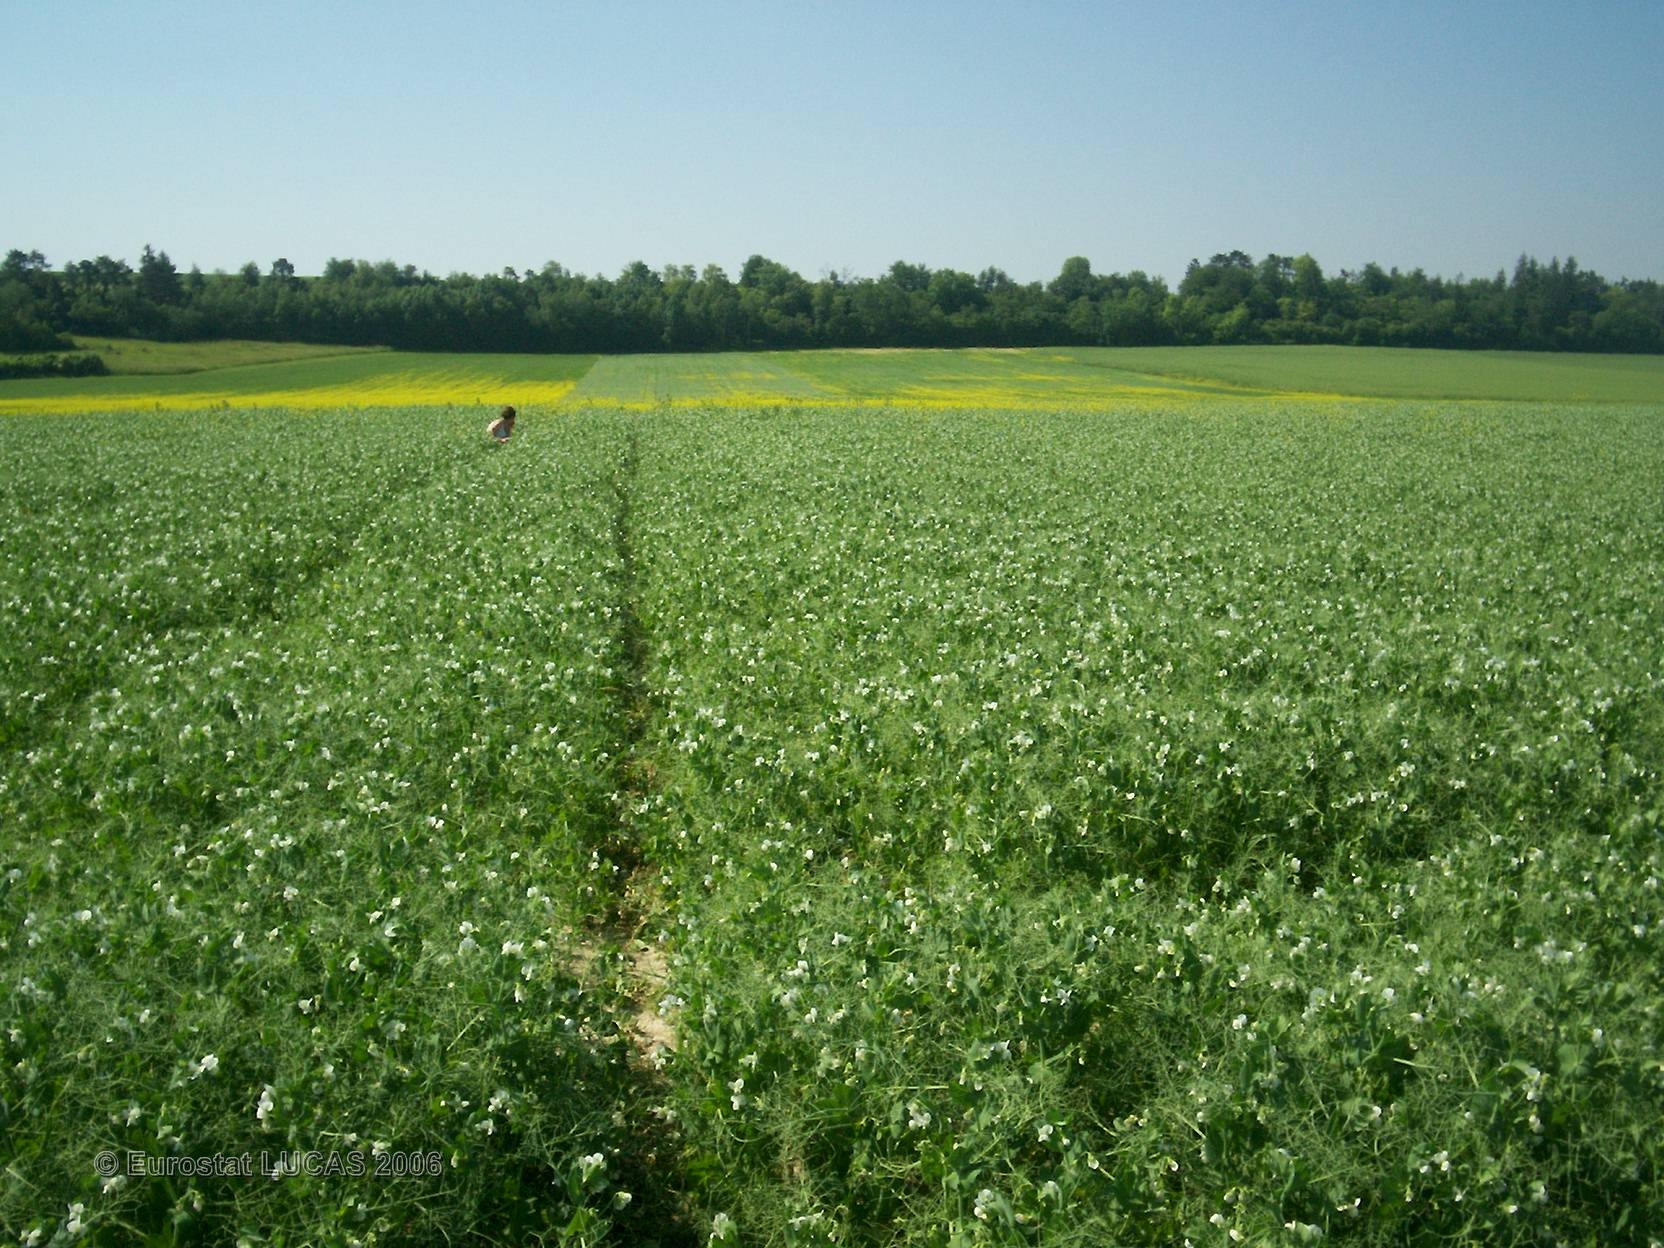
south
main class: Cropland
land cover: Dry pulses
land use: Agriculture (excluding fallow land and kitchen gardens)
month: June
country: FR
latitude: 49.0031
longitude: 4.8167
